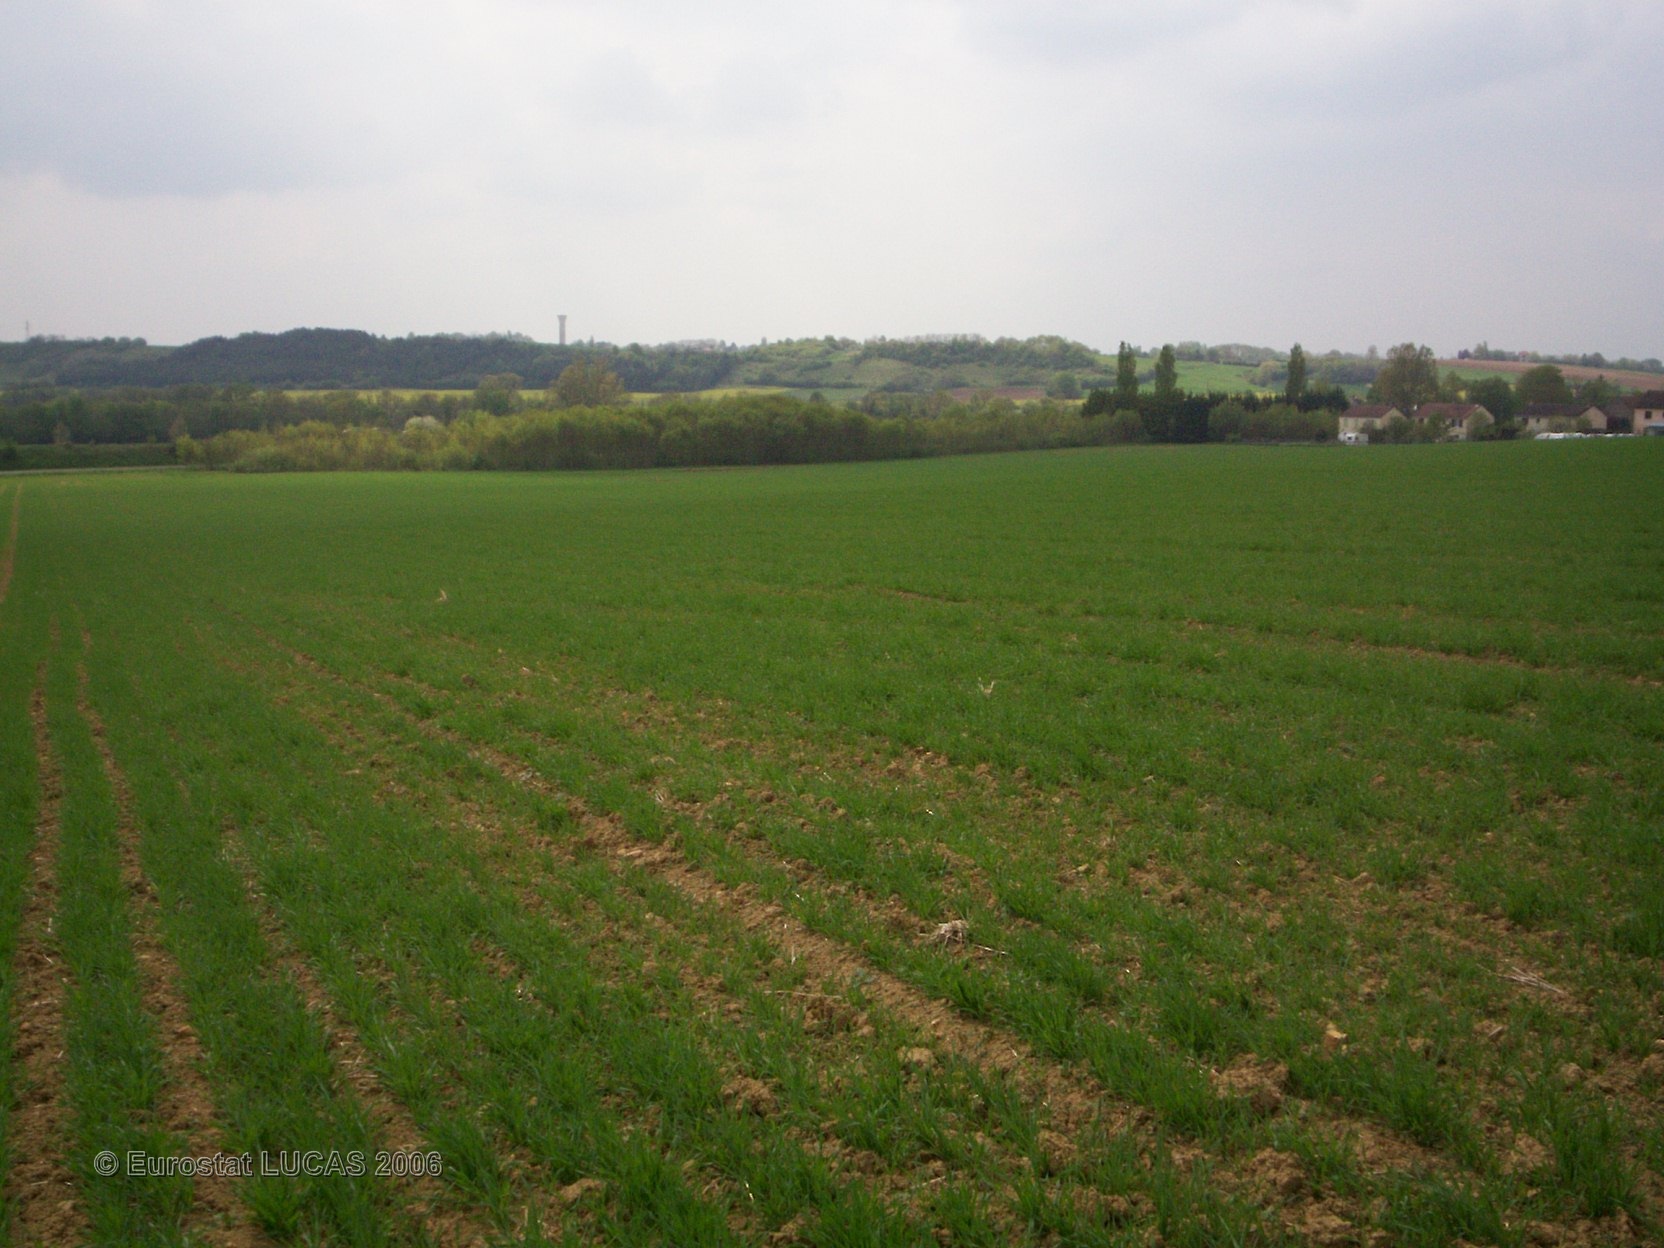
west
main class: Cropland
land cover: Barley
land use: Agriculture (excluding fallow land and kitchen gardens)
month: April
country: FR
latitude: 47.1027
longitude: 3.0781
